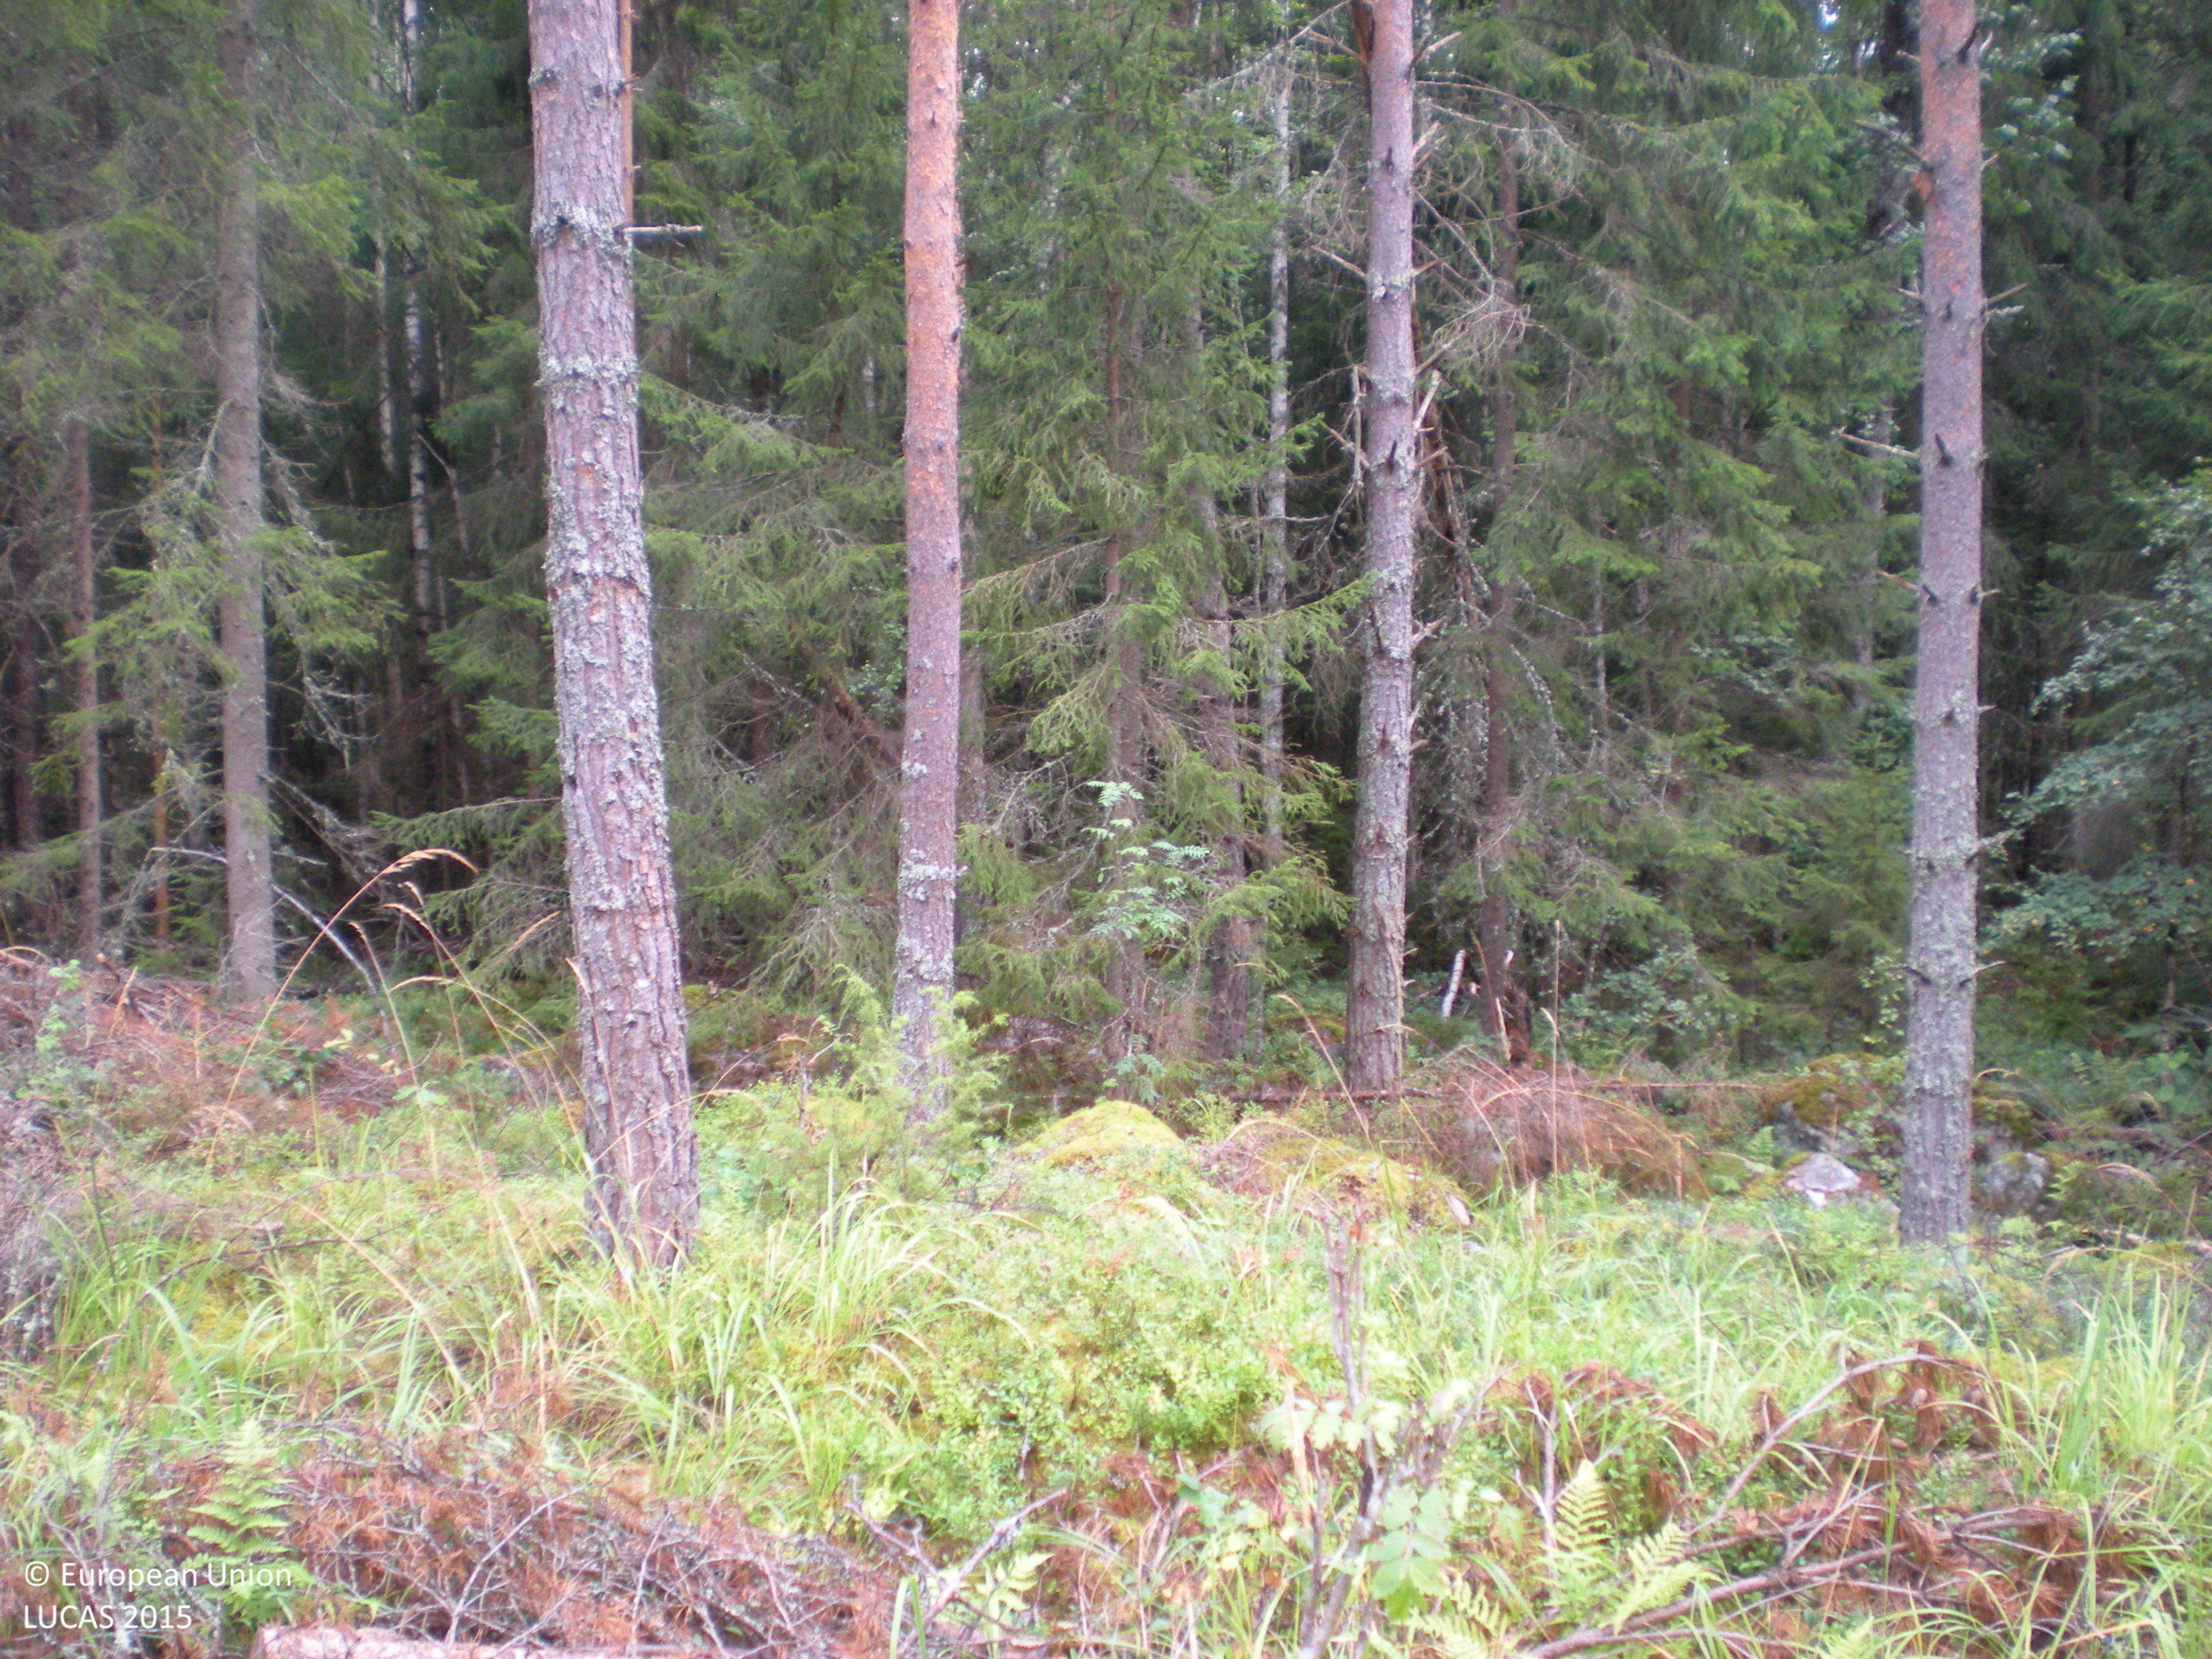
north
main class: Woodland
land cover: Pine dominated coniferous woodland
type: boreal forest
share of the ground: 50 - 75 %
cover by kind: coniferous forest trees 70 %, shrubs 10 %, herbaceous plants 5 %, lichens and mosses 5 %, consolidated bare surface 5 %
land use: Forestry
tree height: > 5 m
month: August
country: SE
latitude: 60.4683
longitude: 17.1743
